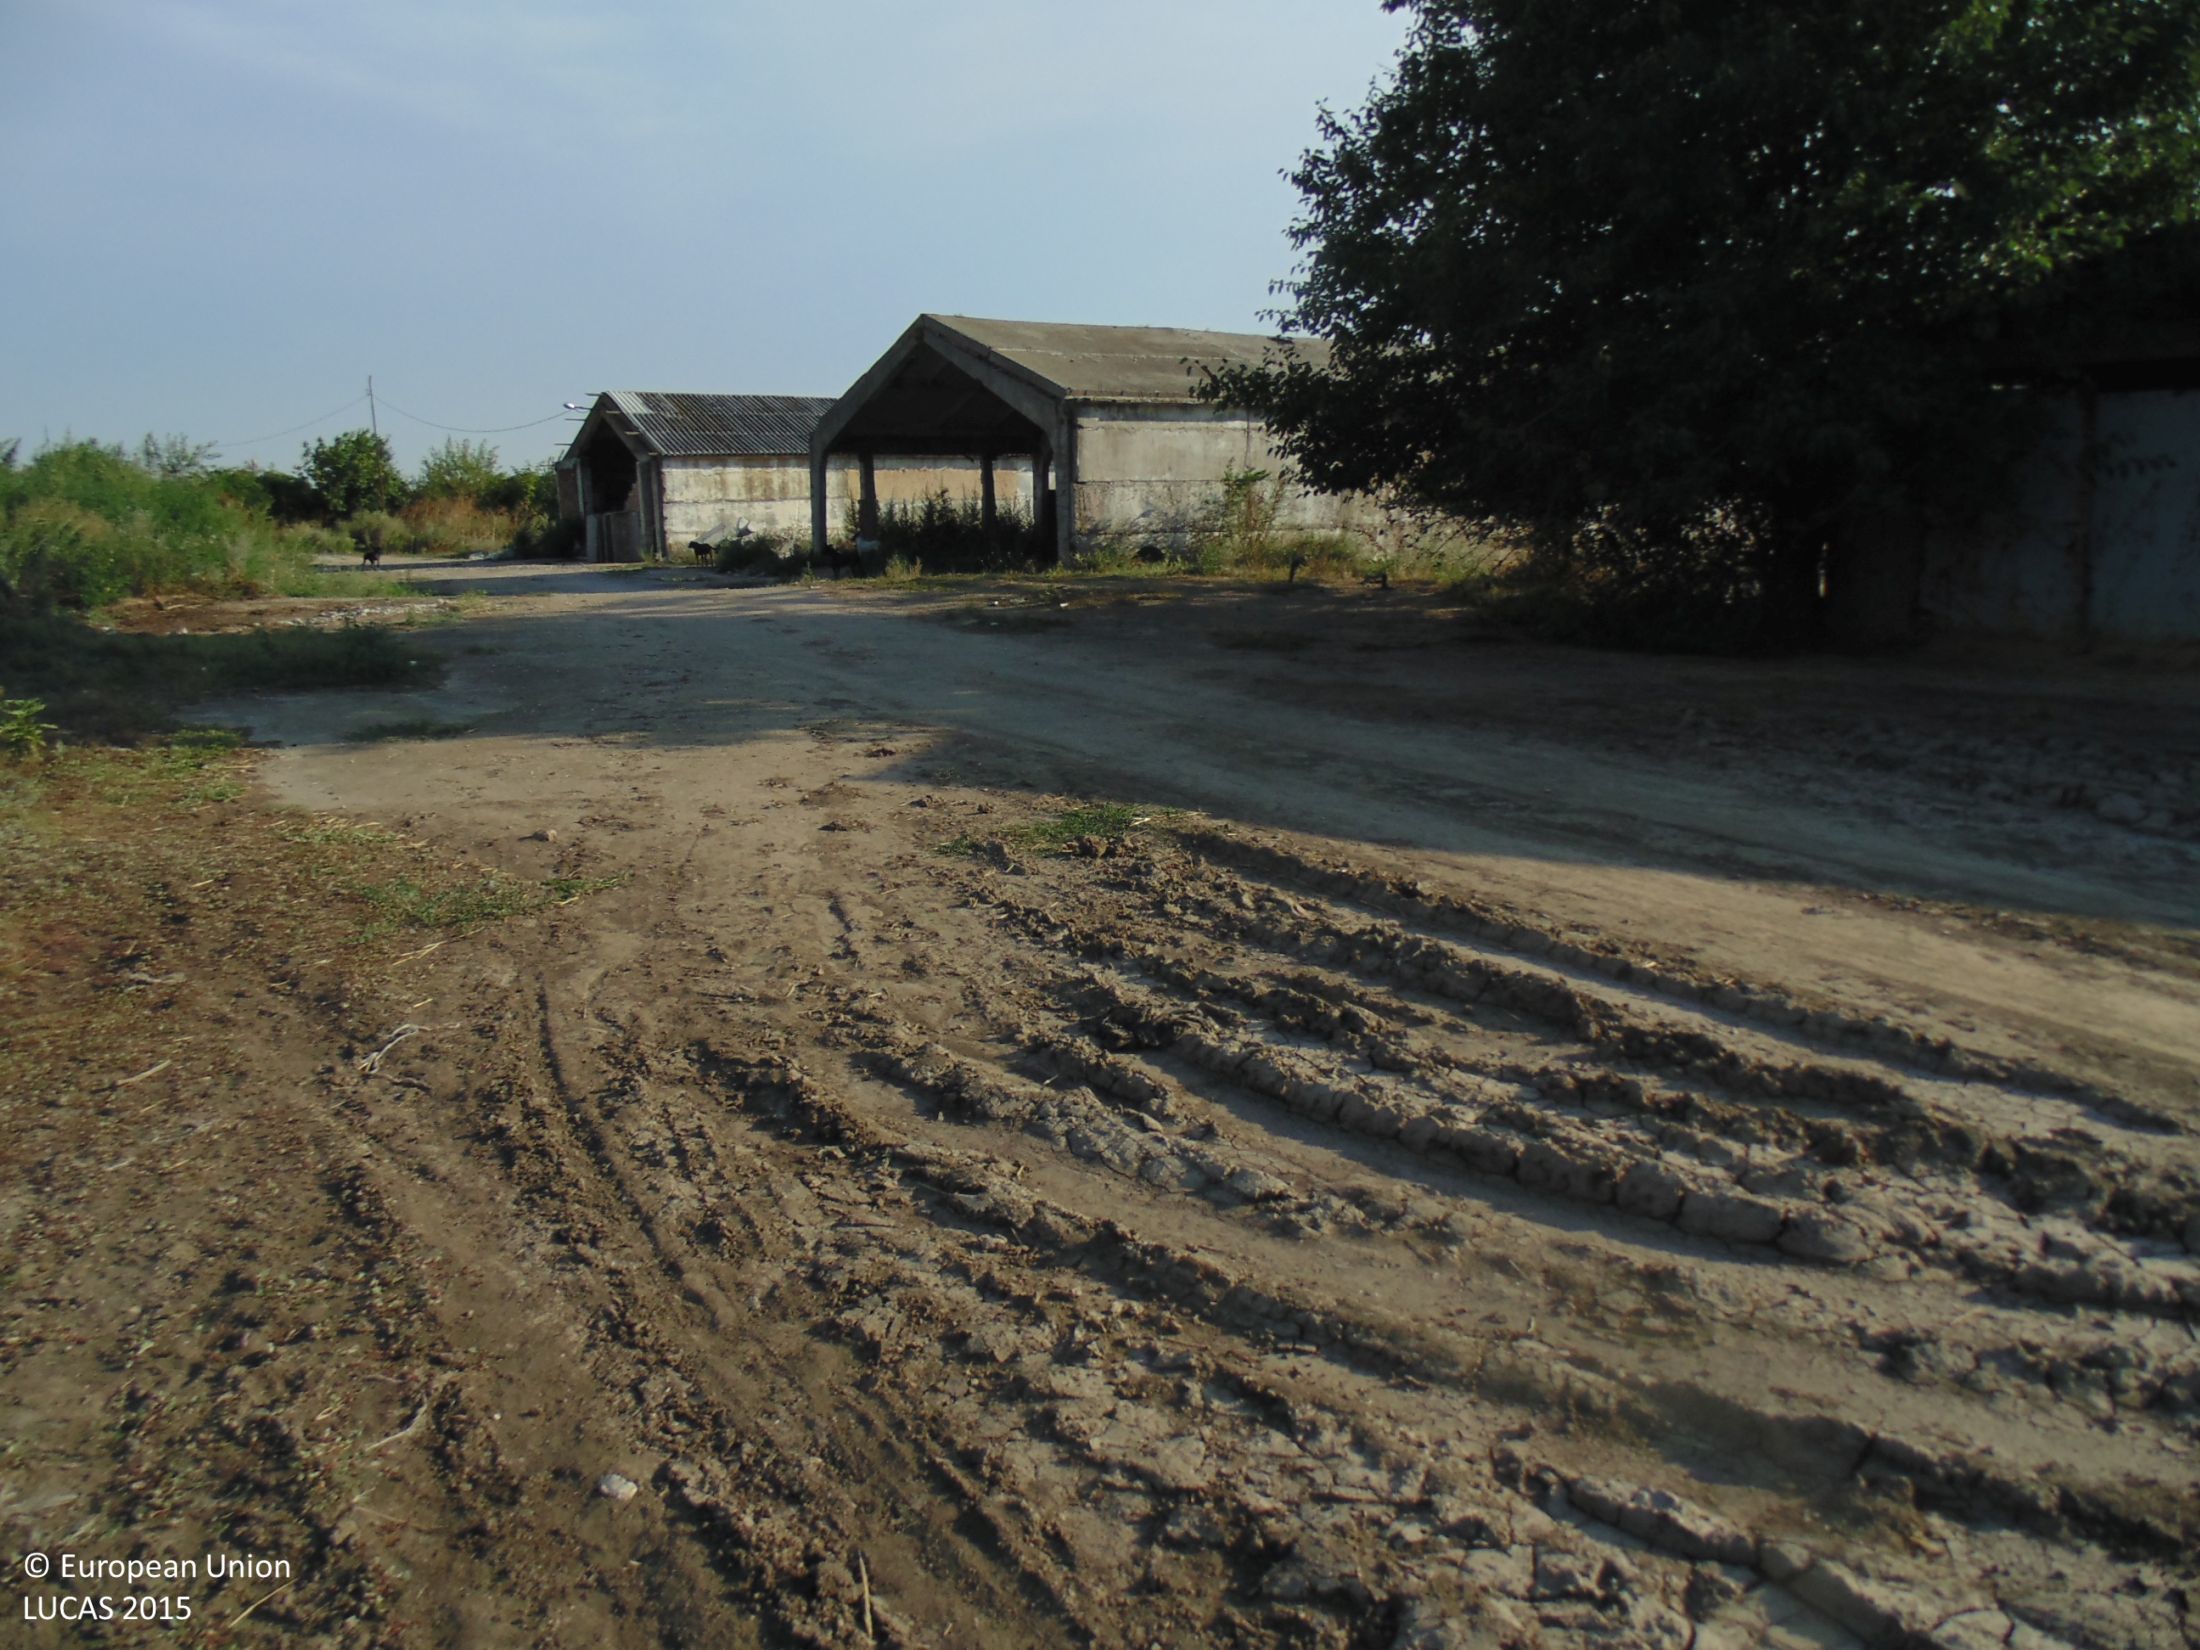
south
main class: Grassland
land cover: Grassland without tree/shrub cover
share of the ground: > 75 %
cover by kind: herbaceous plants 100 %
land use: Abandoned areas
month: August
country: BG
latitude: 43.8481
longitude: 27.7951
